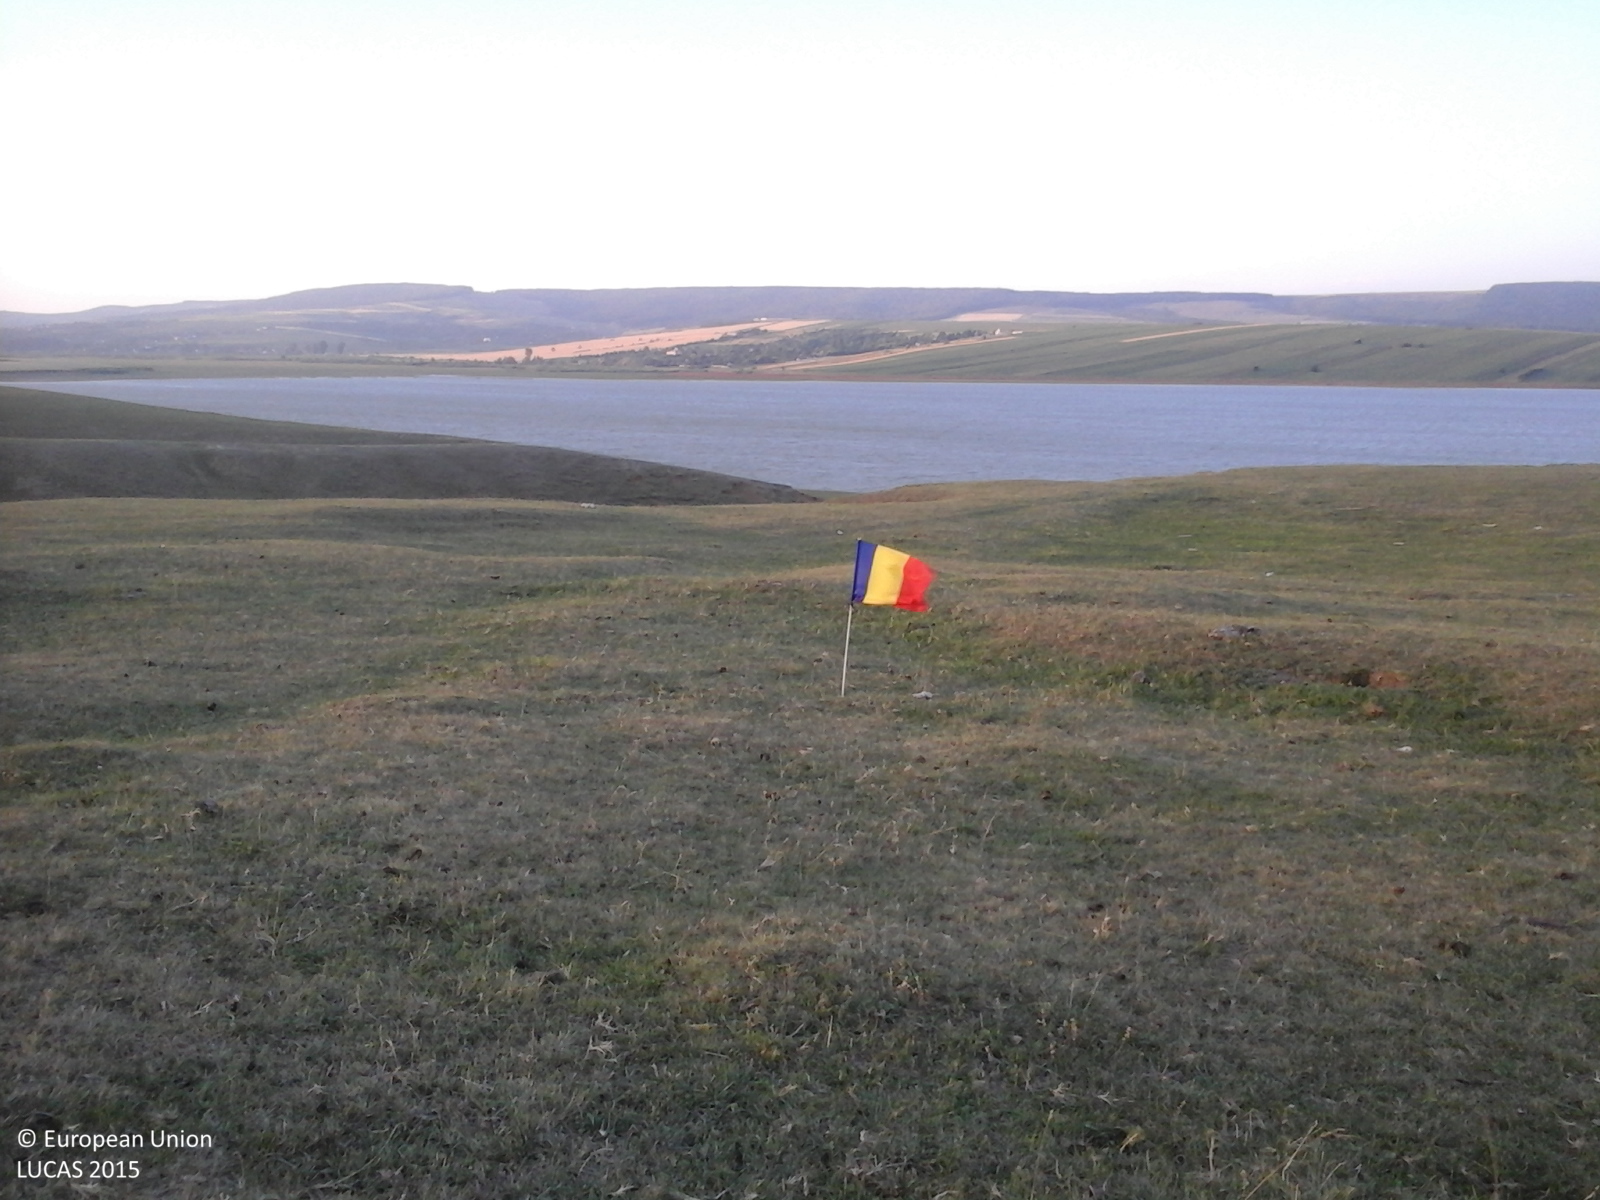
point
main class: Grassland
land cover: Grassland without tree/shrub cover
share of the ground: > 75 %
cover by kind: herbaceous plants 100 %
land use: Agriculture (excluding fallow land and kitchen gardens)
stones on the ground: < 10 %
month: June
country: RO
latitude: 46.9467
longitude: 27.3331
